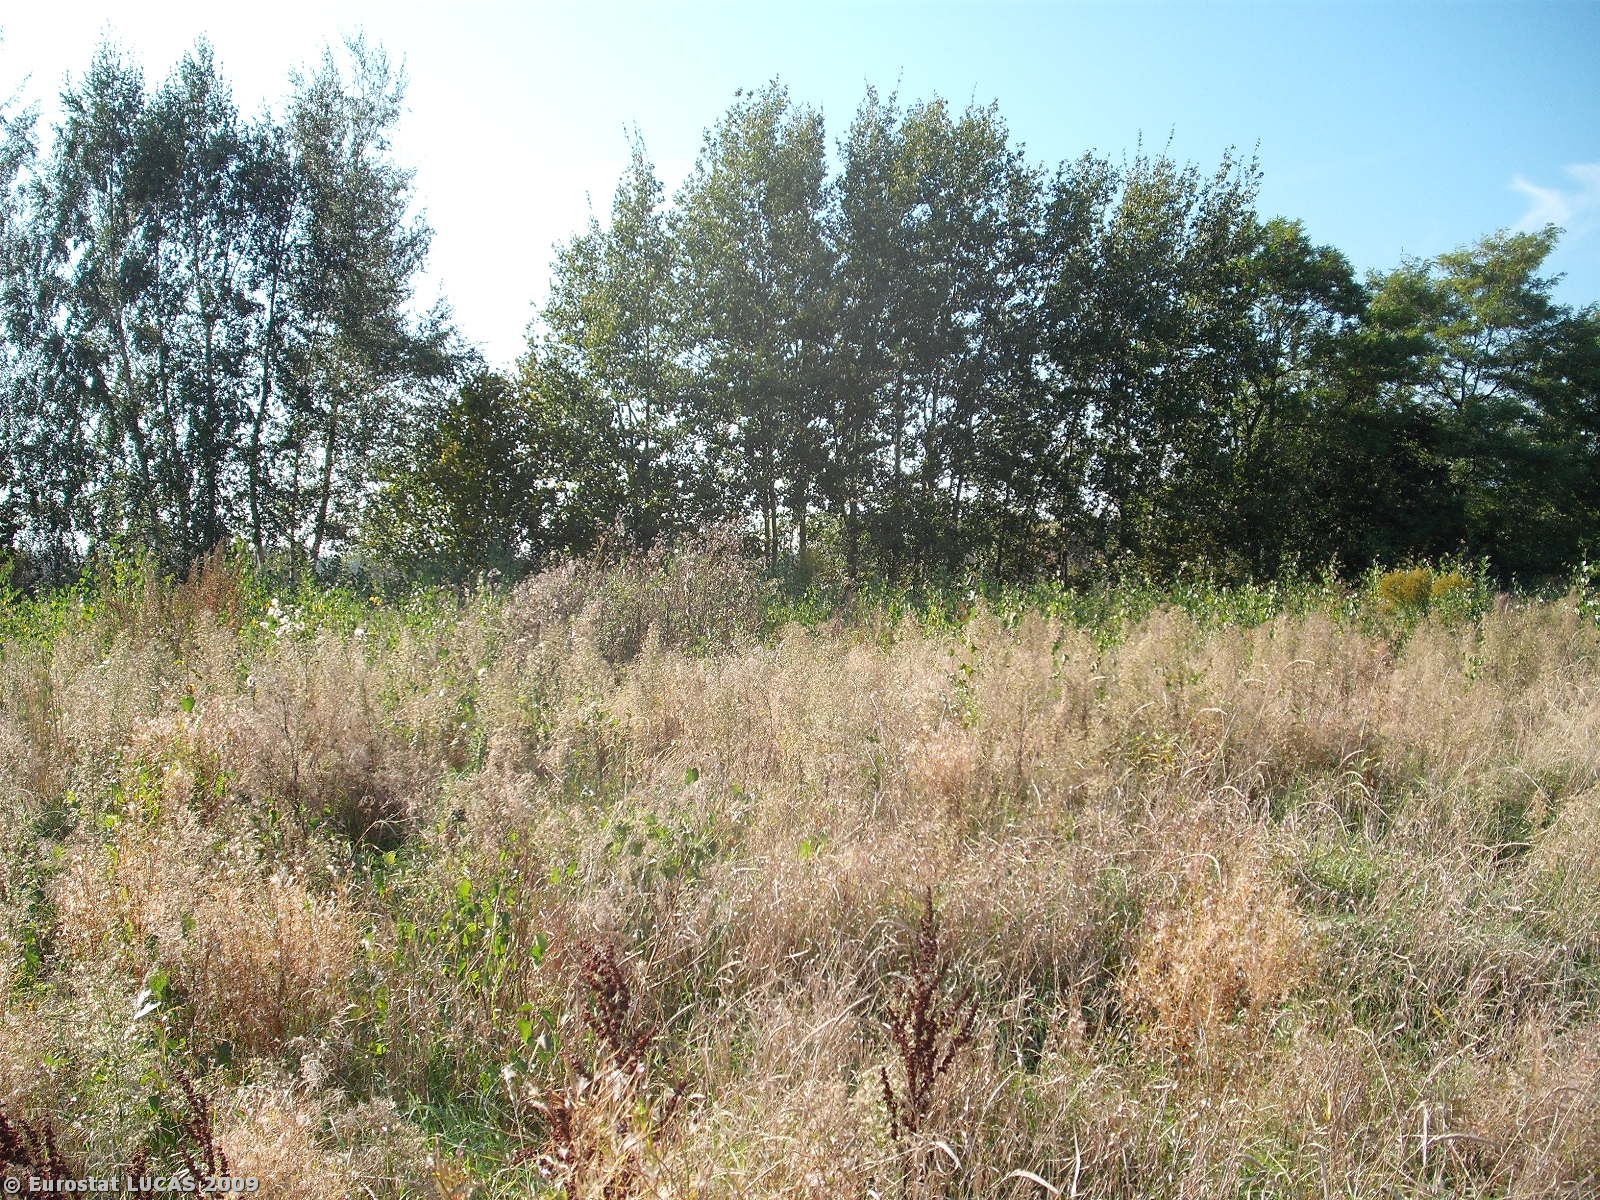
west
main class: Grassland
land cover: Spontaneously vegetated surfaces
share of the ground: > 75 %
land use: Unused
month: September
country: PL
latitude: 51.8460
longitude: 21.0040
